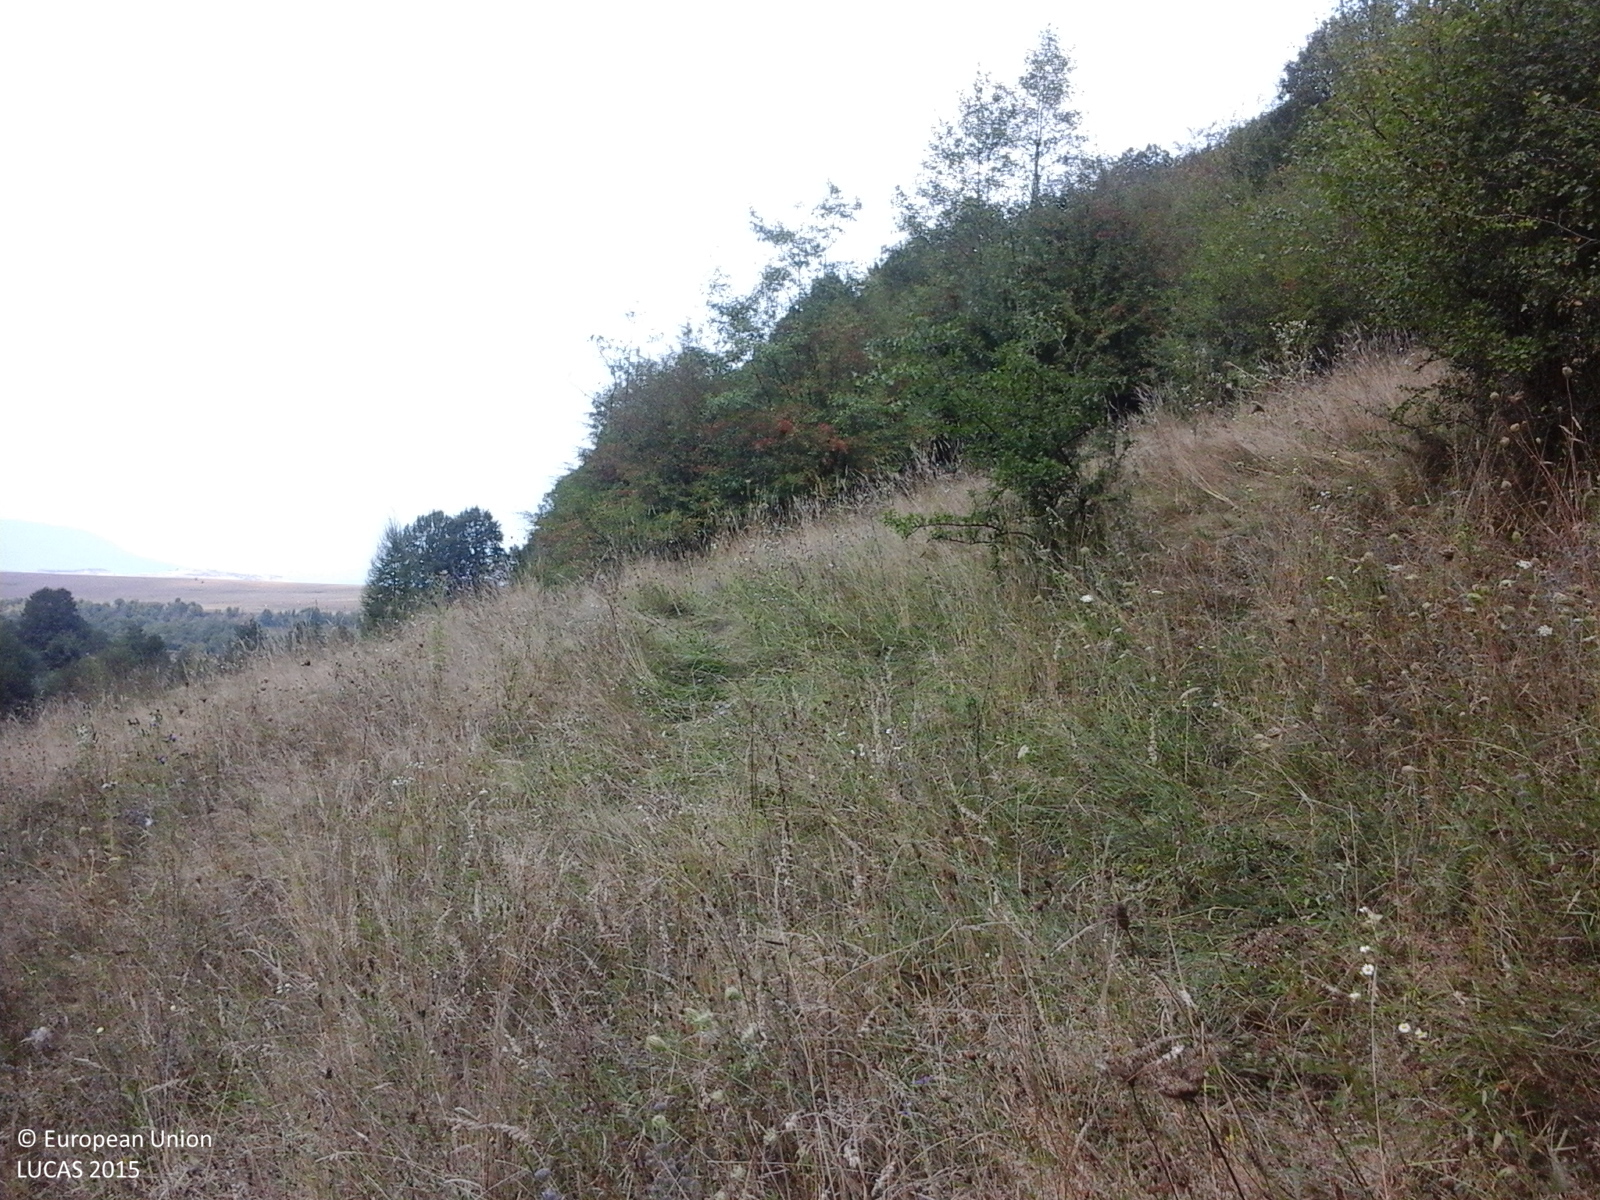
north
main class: Grassland
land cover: Grassland with sparse tree/shrub cover
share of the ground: > 75 %
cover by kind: herbaceous plants 90 %, broadleaved forest trees 5 %, shrubs 5 %
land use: Agriculture (excluding fallow land and kitchen gardens)
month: September
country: RO
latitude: 47.4421
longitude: 23.9391
